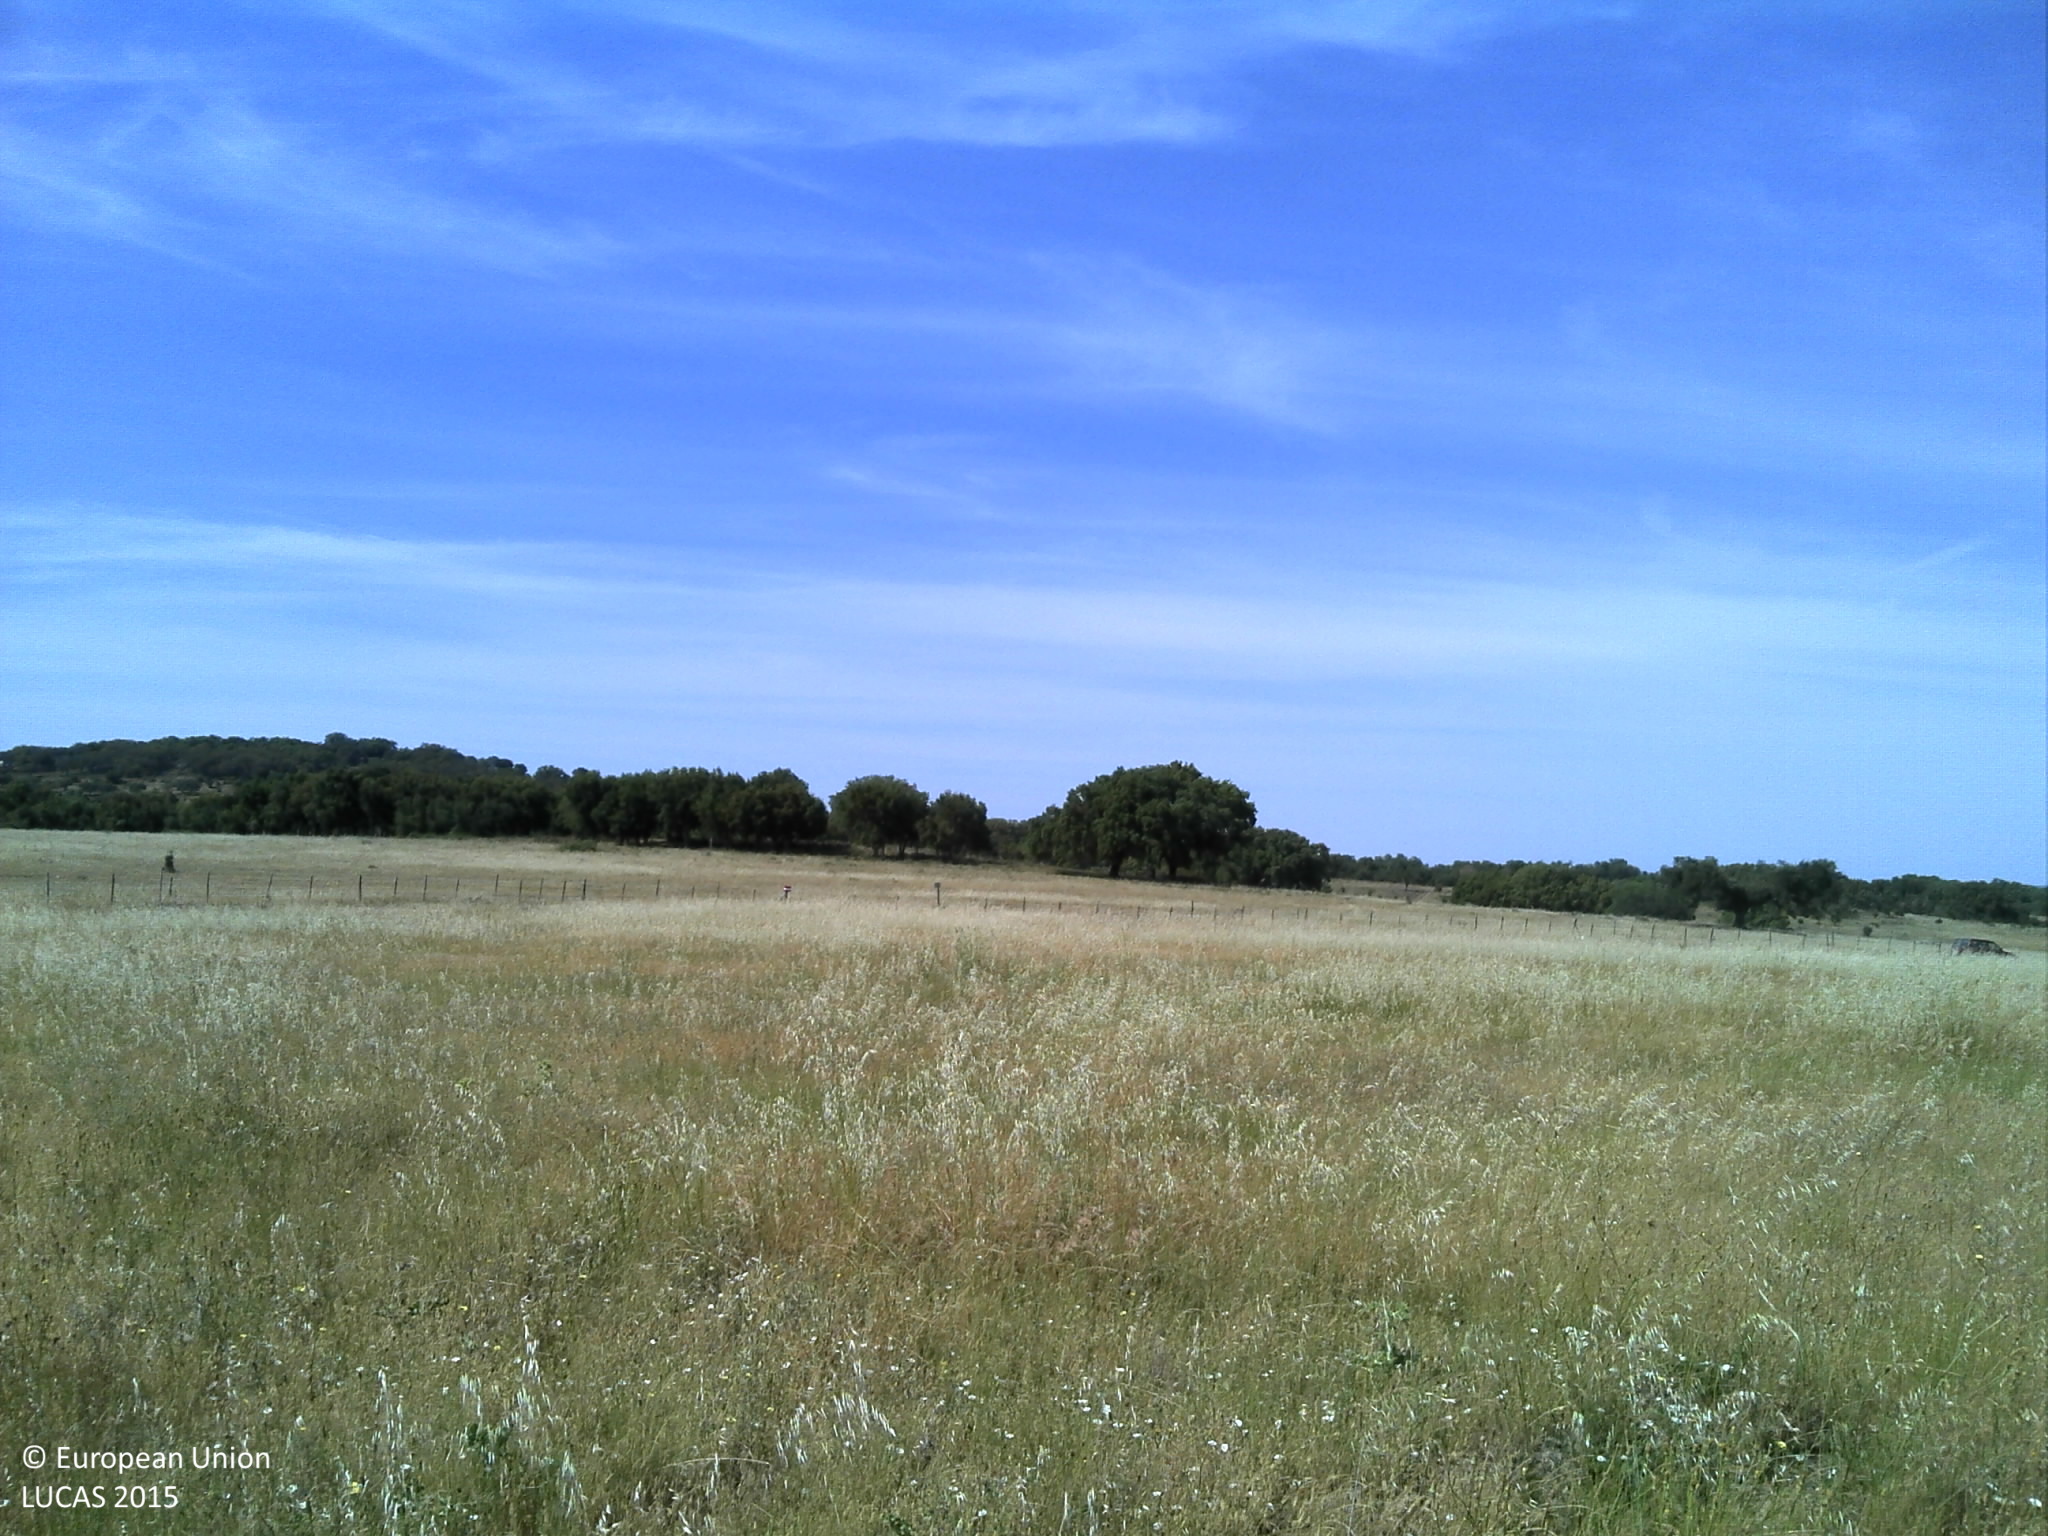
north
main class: Grassland
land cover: Grassland without tree/shrub cover
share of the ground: > 75 %
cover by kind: herbaceous plants 90 %, unconsolidated bare surface 10 %
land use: Agriculture (excluding fallow land and kitchen gardens)
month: May
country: PT
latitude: 39.2002
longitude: -7.5862
